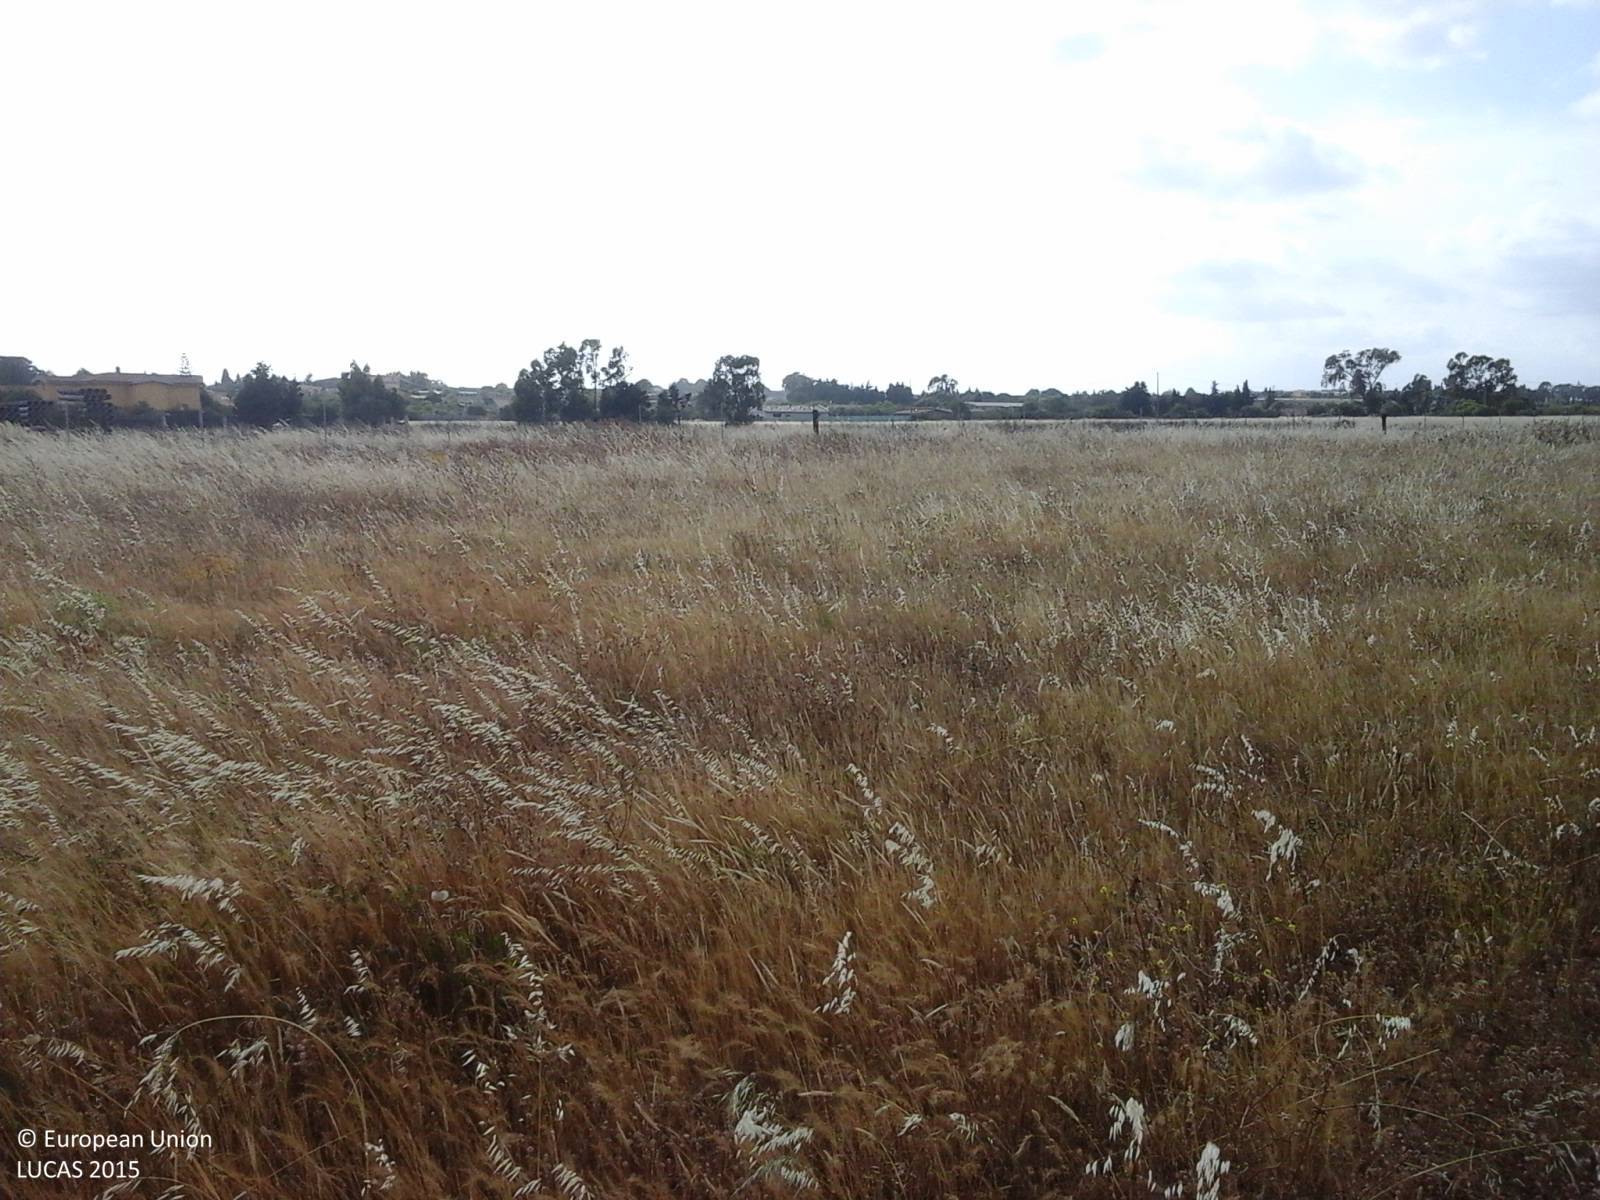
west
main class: Grassland
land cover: Spontaneously vegetated surfaces
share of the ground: > 75 %
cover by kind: herbaceous plants 100 %
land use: Fallow land
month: May
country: IT
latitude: 39.2503
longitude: 9.2745
